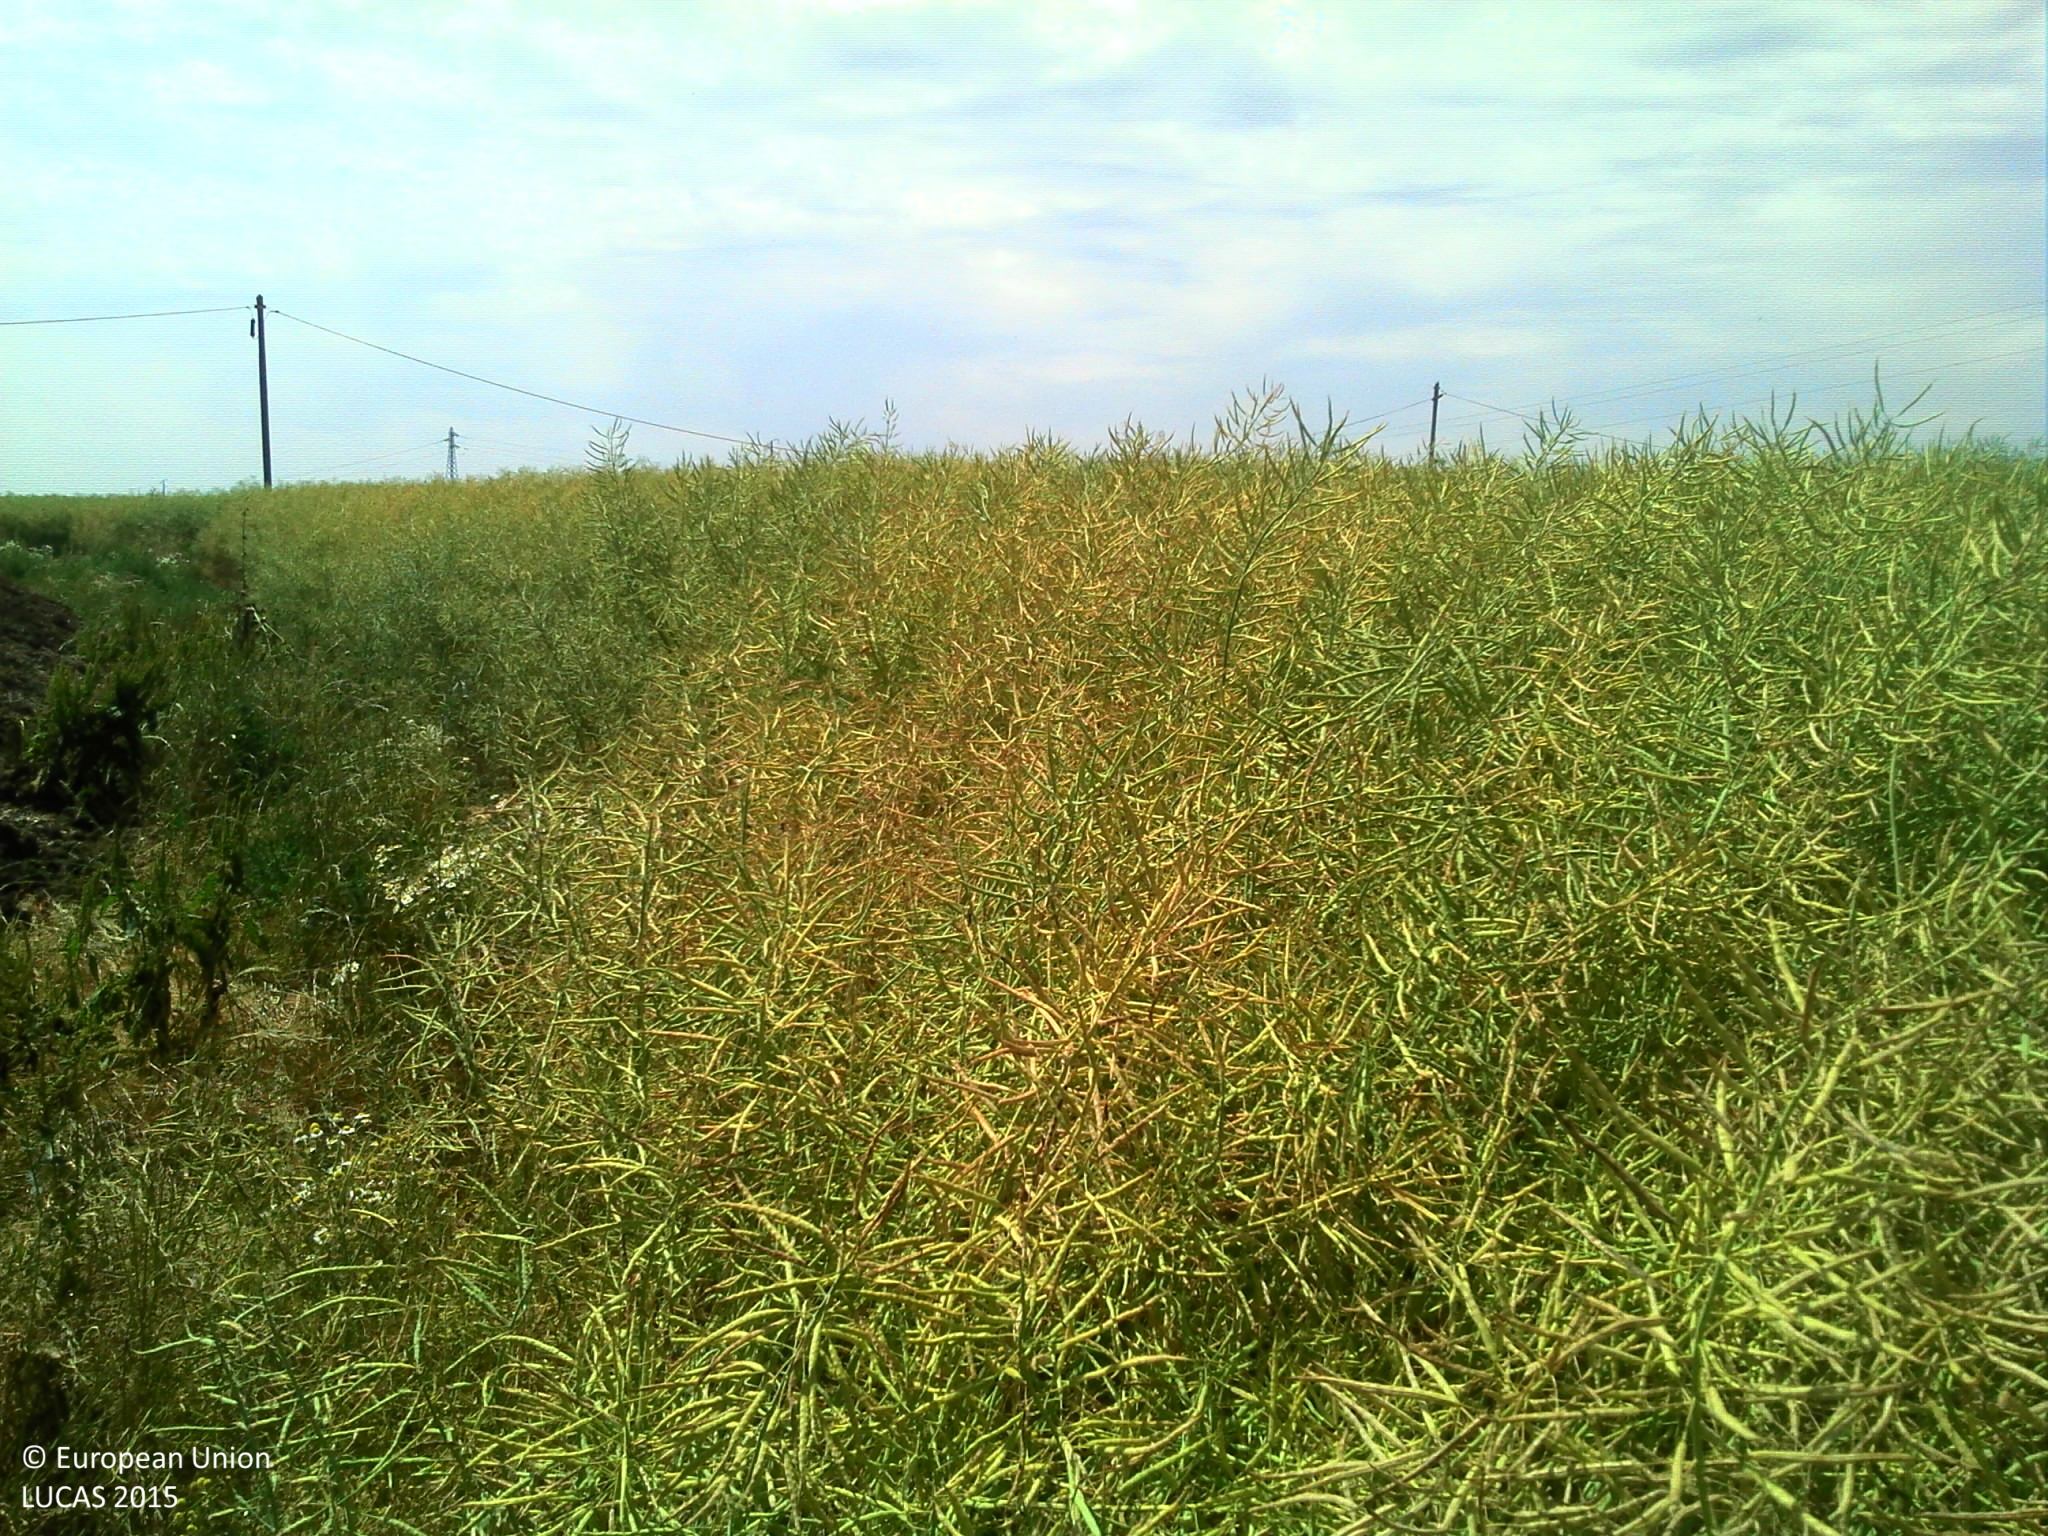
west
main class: Cropland
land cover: Rape and turnip rape
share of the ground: > 75 %
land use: Agriculture (excluding fallow land and kitchen gardens)
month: June
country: FR
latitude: 49.0682
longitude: 1.2338
